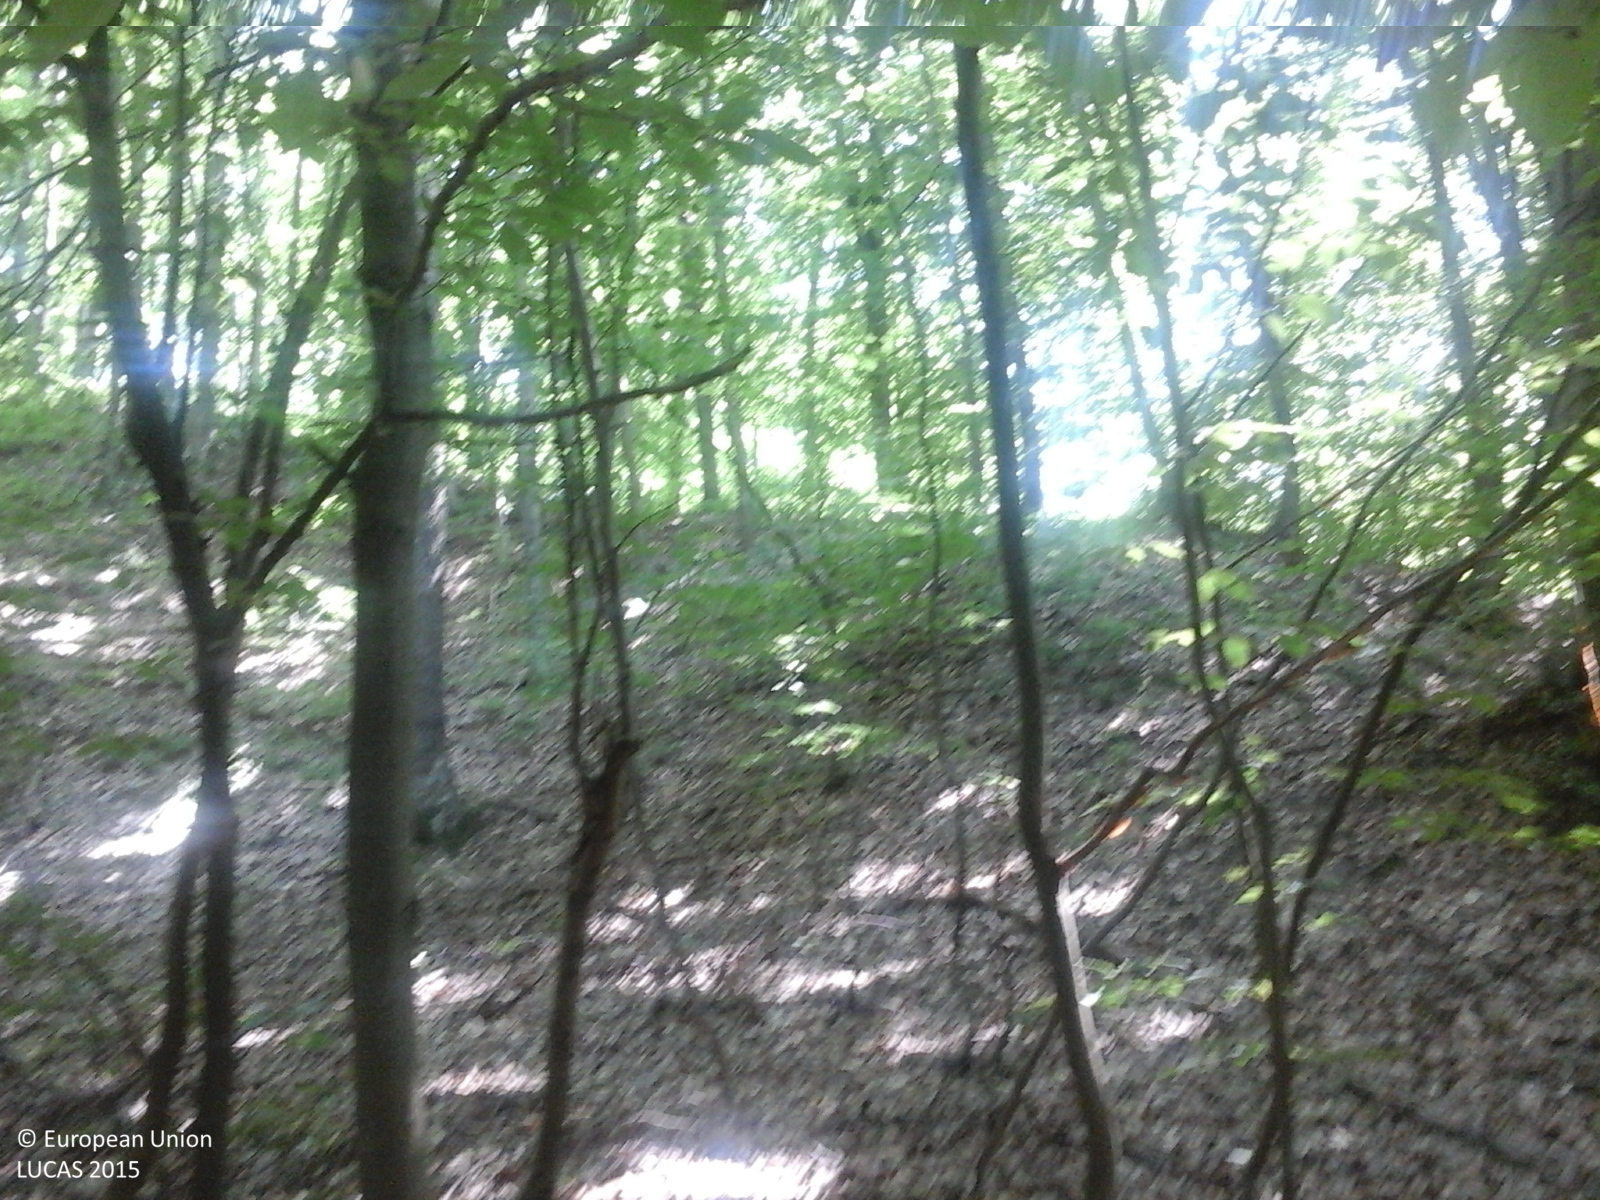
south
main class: Woodland
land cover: Broadleaved woodland
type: mesophytic deciduous forest
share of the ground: > 75 %
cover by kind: broadleaved forest trees 100 %
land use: Forestry
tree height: > 5 m
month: July
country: RO
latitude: 44.7728
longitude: 24.7488
